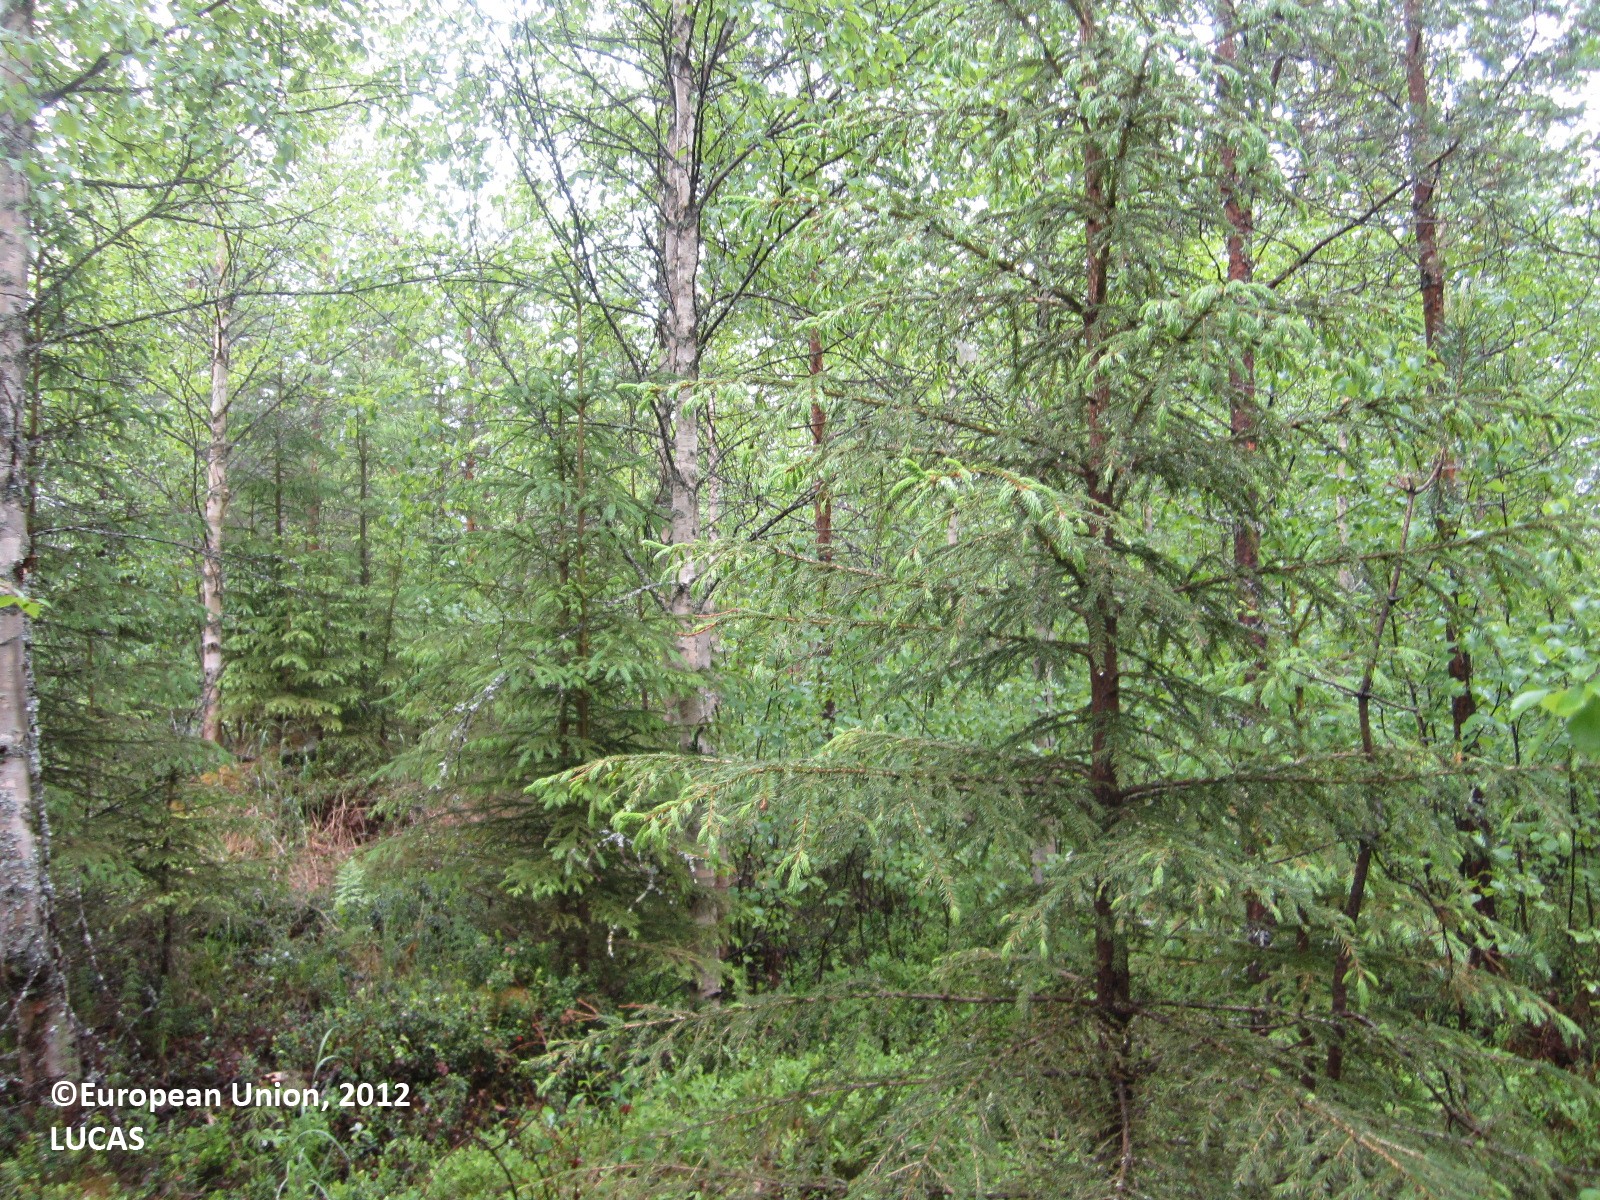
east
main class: Woodland
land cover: Spruce dominated mixed woodland
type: boreal forest
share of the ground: 50 - 75 %
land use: Forestry
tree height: > 5 m
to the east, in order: Spruce dominated mixed woodland; Pine dominated mixed woodland; Ditches and canals; Pine dominated coniferous woodland; Ditches and canals; Pine dominated coniferous woodland; Pine dominated mixed woodland; Ditches and canals; Pine dominated mixed woodland; Grassland with sparse tree/shrub cover; Abandoned hedges; Ditches and canals; Abandoned hedges; Spontaneously vegetated surfaces; Broadleaved woodland; Inland water bodies; Pine dominated mixed woodland; Rocks and stones
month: June
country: FI
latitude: 64.3892
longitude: 29.4765
